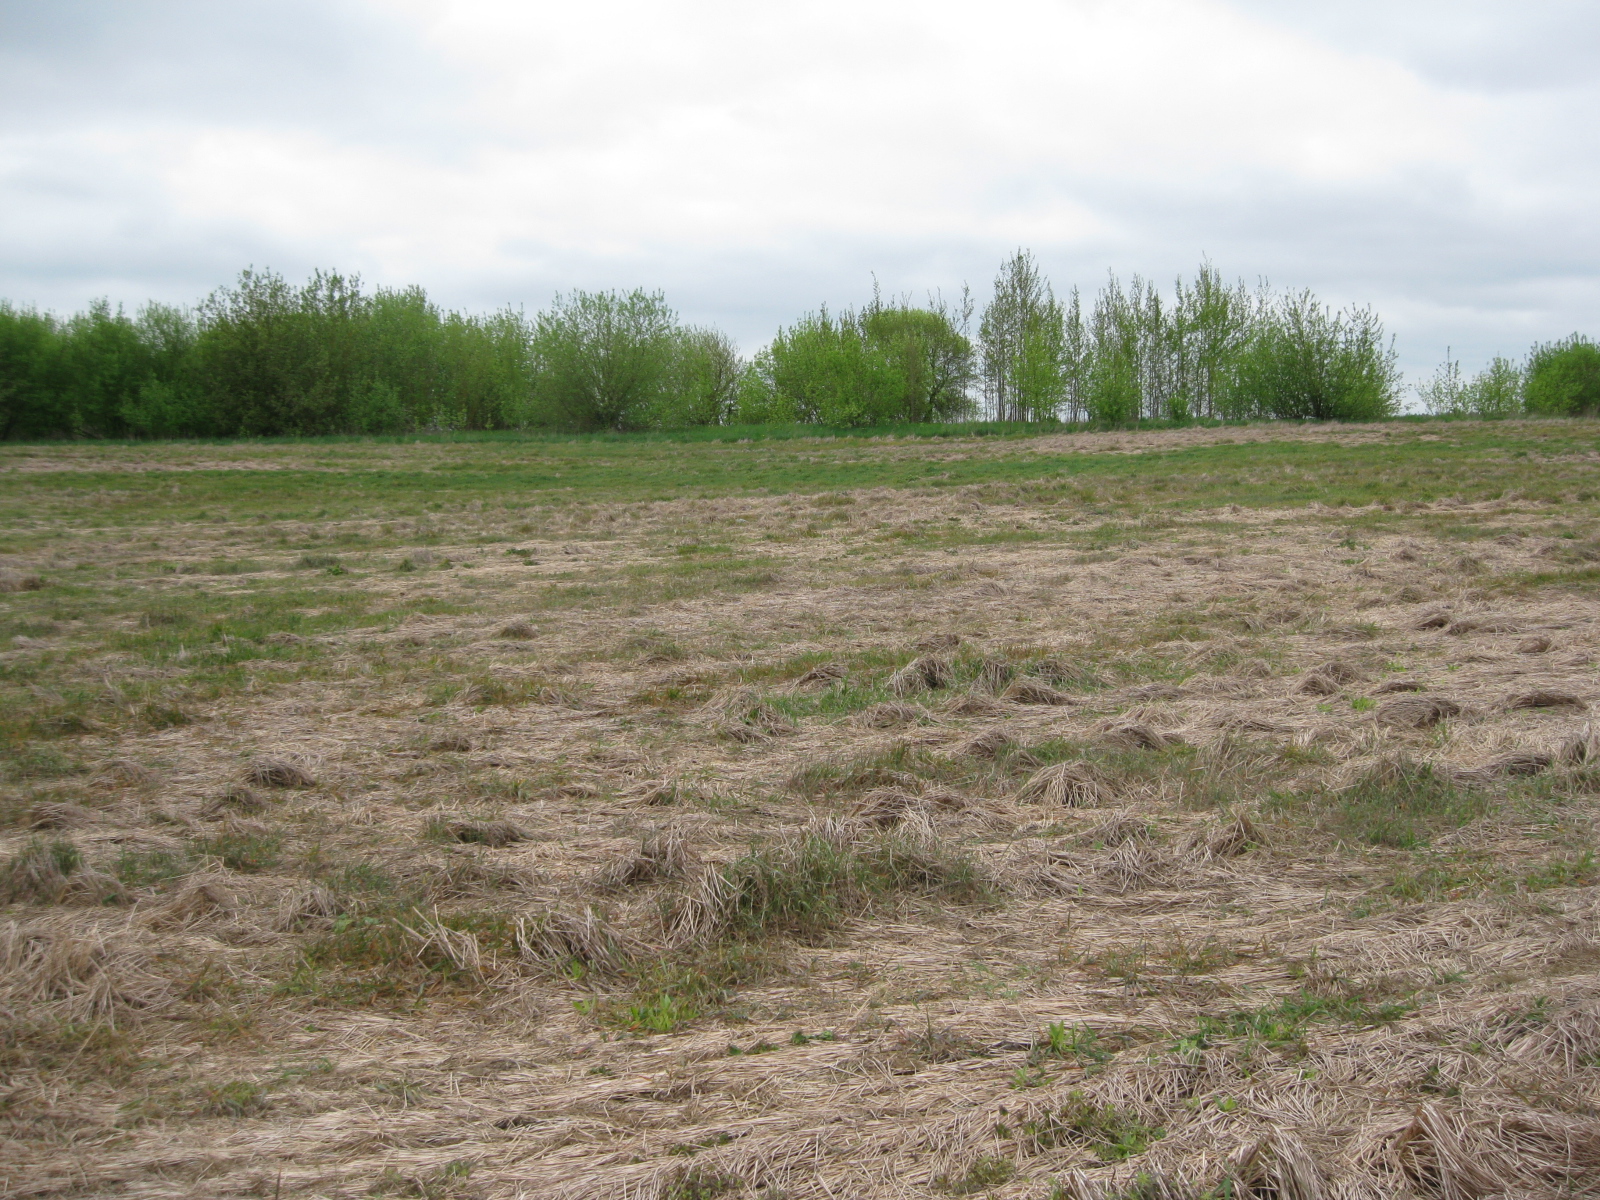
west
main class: Grassland
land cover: Spontaneously vegetated surfaces
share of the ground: 10 - 25 %
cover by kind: unconsolidated bare surface 30 %, herbaceous plants 20 %
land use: Fallow land
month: May
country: LT
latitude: 55.9413
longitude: 24.3606
